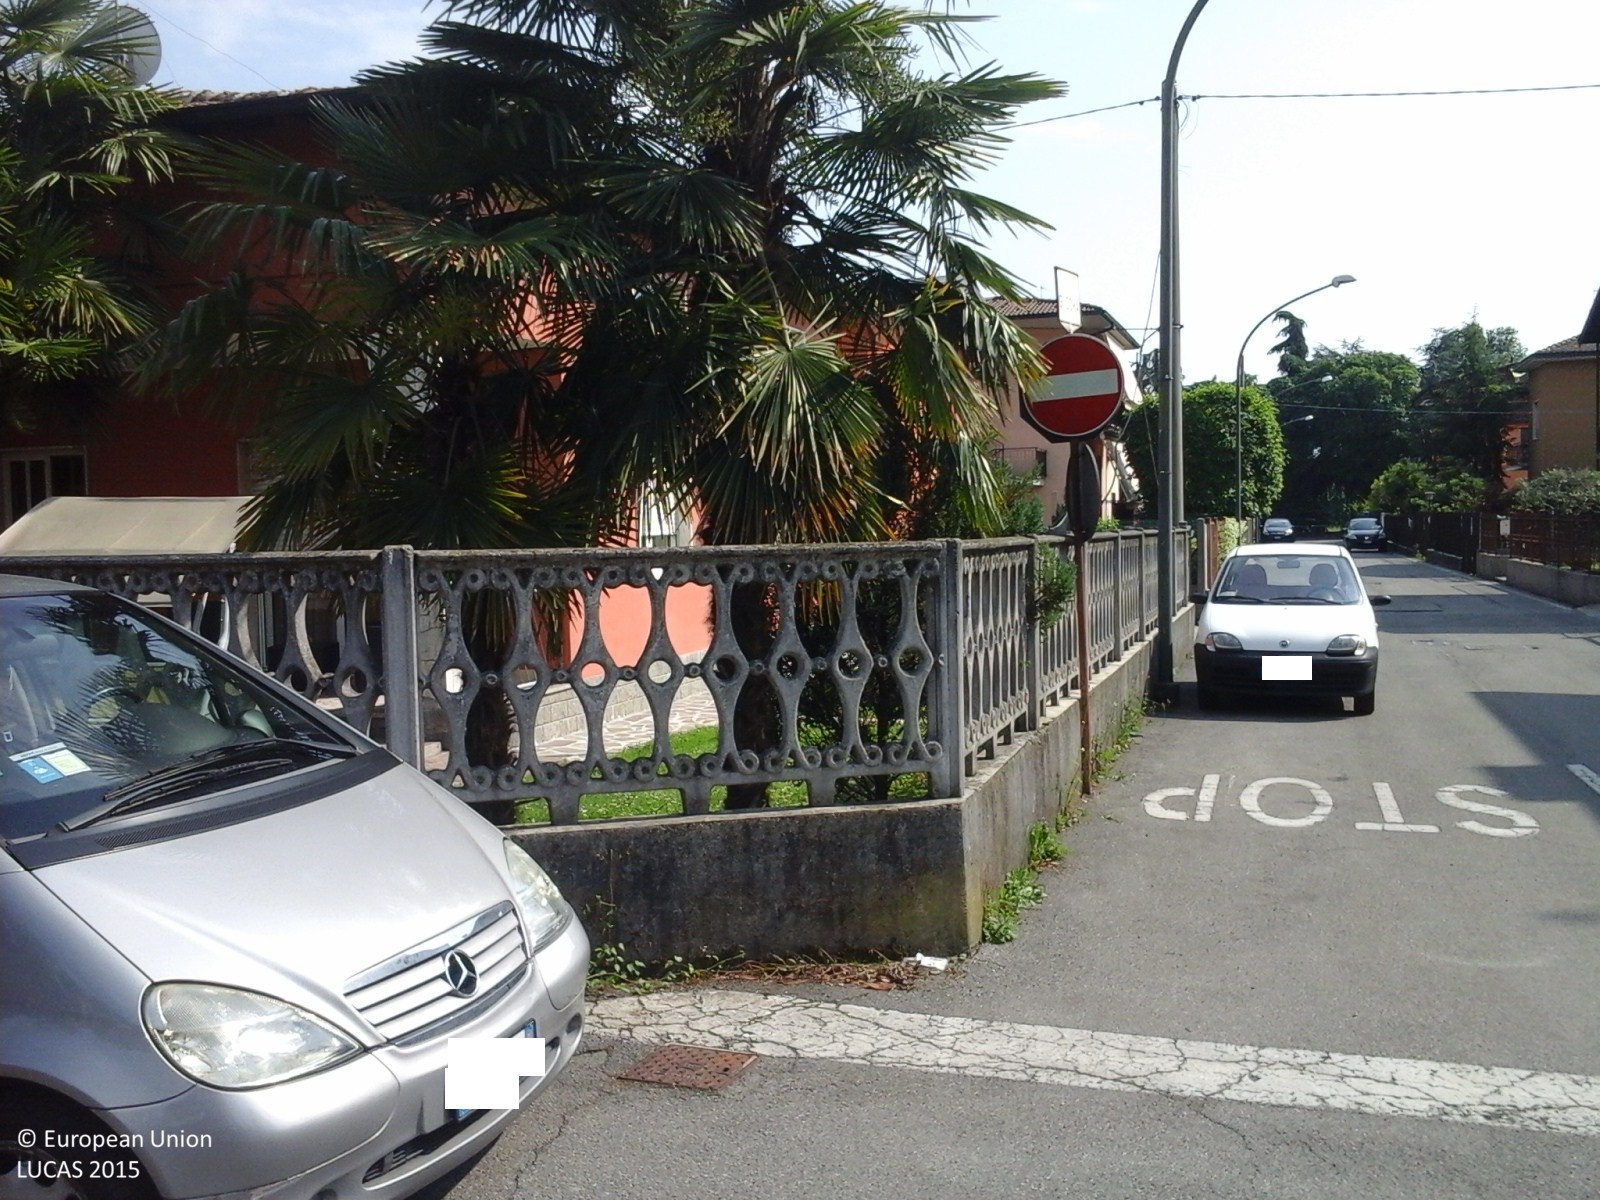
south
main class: Grassland
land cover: Grassland with sparse tree/shrub cover
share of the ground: > 75 %
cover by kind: herbaceous plants 90 %, broadleaved forest trees 5 %, shrubs 5 %
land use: Residential
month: May
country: IT
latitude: 45.6480
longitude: 9.6541
